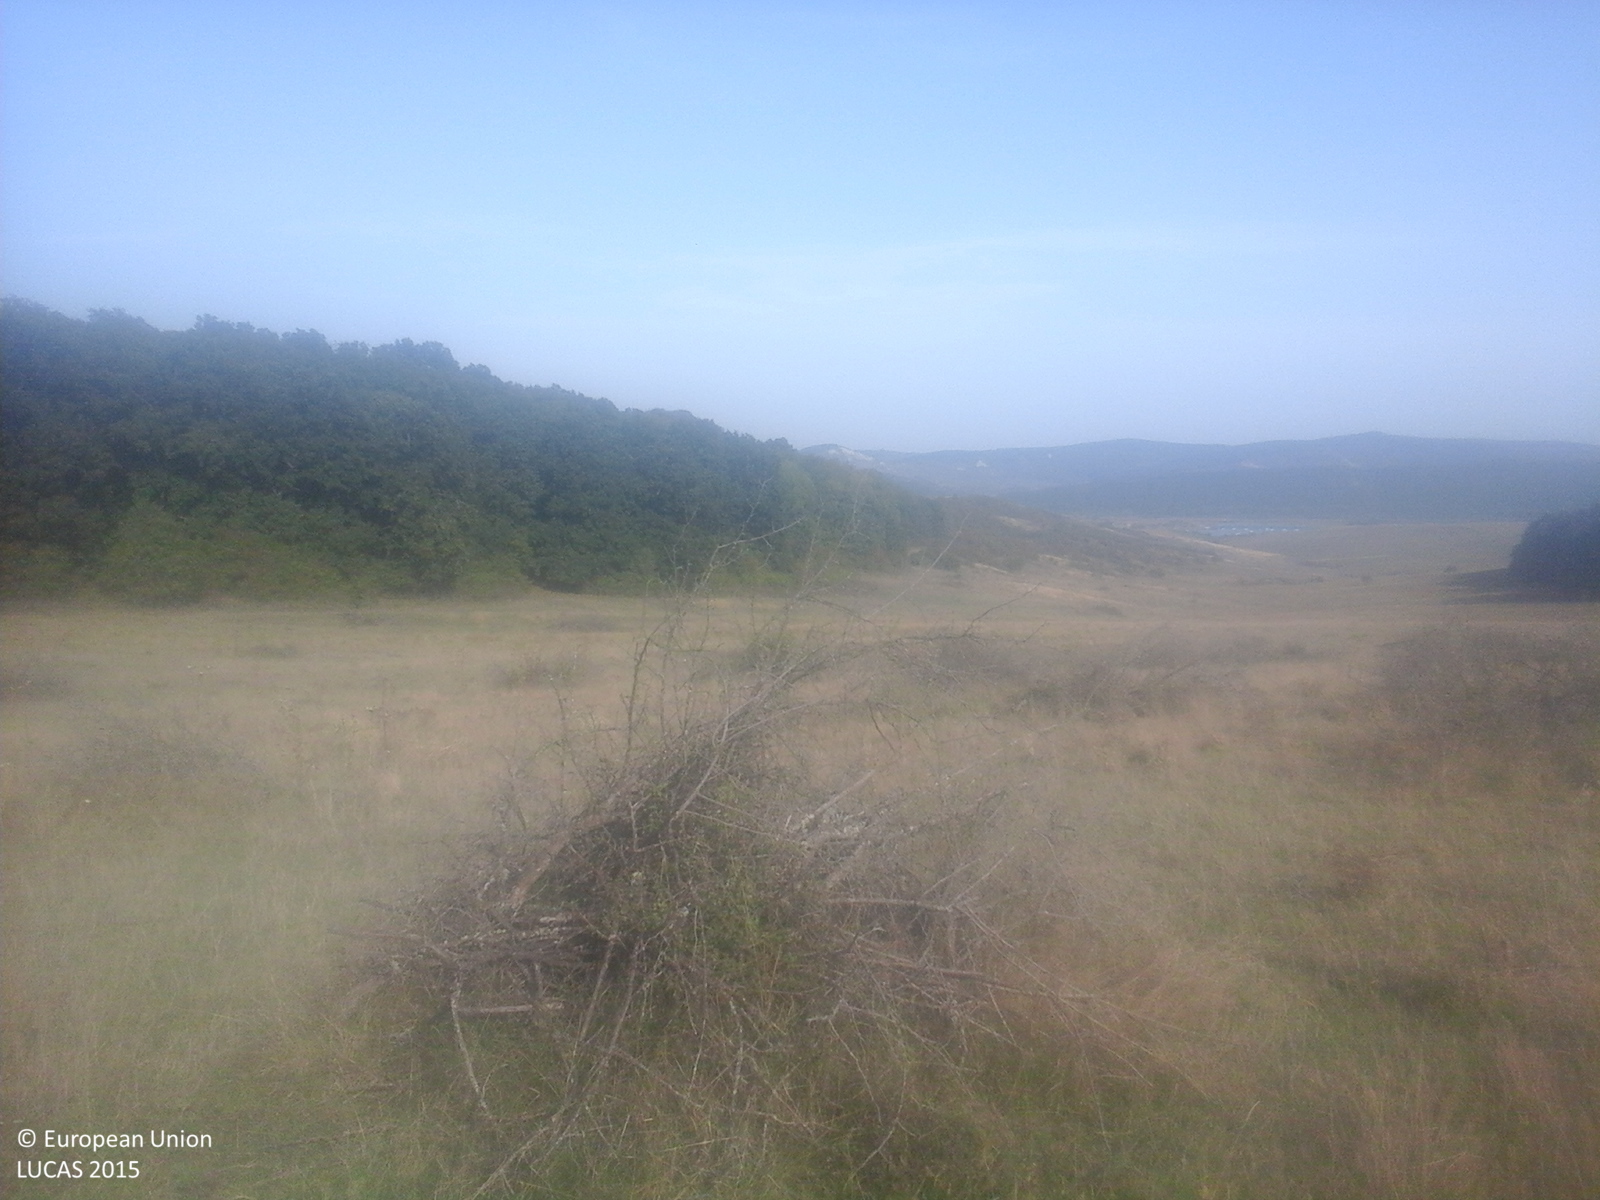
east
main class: Grassland
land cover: Grassland with sparse tree/shrub cover
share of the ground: > 75 %
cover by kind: herbaceous plants 85 %, shrubs 10 %, broadleaved forest trees 5 %
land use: Agriculture (excluding fallow land and kitchen gardens)
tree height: < 5 m
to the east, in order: Grassland with sparse tree/shrub cover; Grassland without tree/shrub cover; Tracks; Grassland with sparse tree/shrub cover
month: September
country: RO
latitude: 46.9724
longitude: 23.7587
